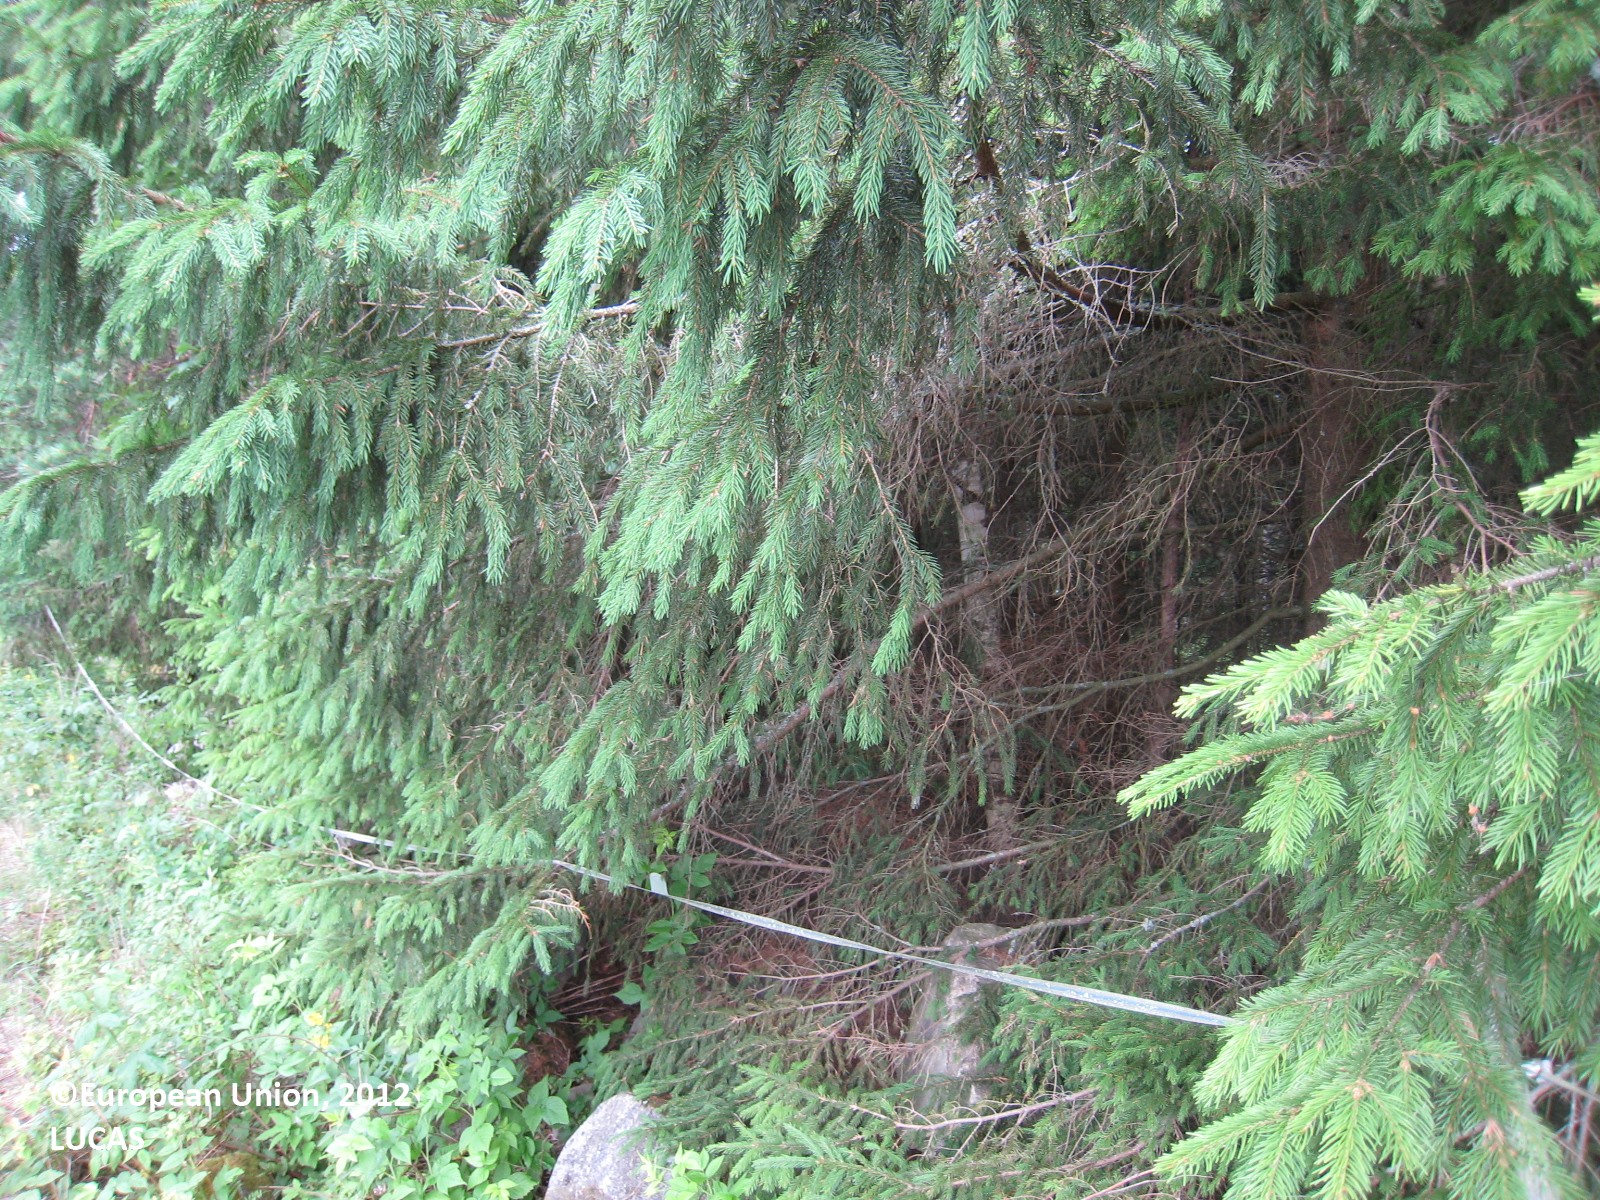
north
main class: Woodland
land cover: Other mixed woodland
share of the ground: > 75 %
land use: Semi-natural and natural areas not in use
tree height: > 5 m
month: July
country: FI
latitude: 61.8677
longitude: 27.0614
